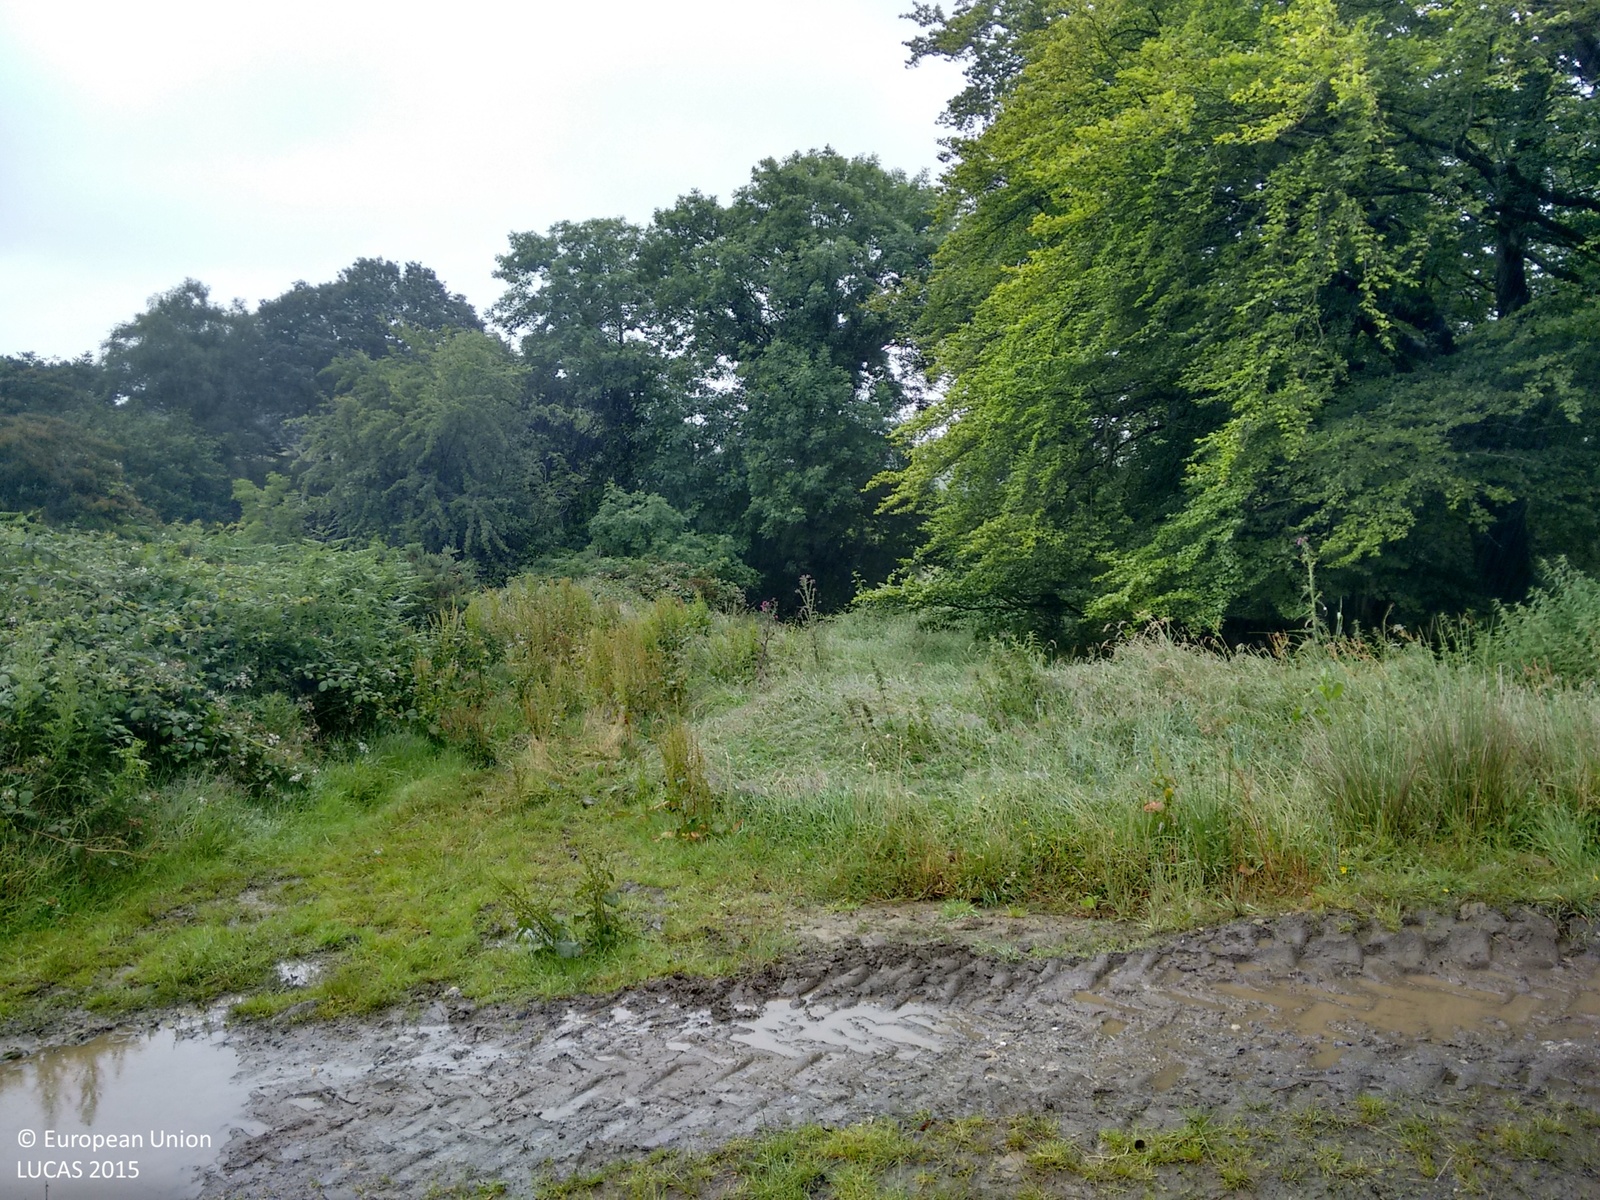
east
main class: Grassland
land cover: Grassland without tree/shrub cover
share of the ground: > 75 %
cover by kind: herbaceous plants 100 %
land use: Agriculture (excluding fallow land and kitchen gardens)
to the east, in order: Grassland without tree/shrub cover; Tracks; Broadleaved woodland; Inland fresh running water; Grassland without tree/shrub cover; Lines of trees; Grassland without tree/shrub cover
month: July
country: IE
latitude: 52.9050
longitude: -6.3438
